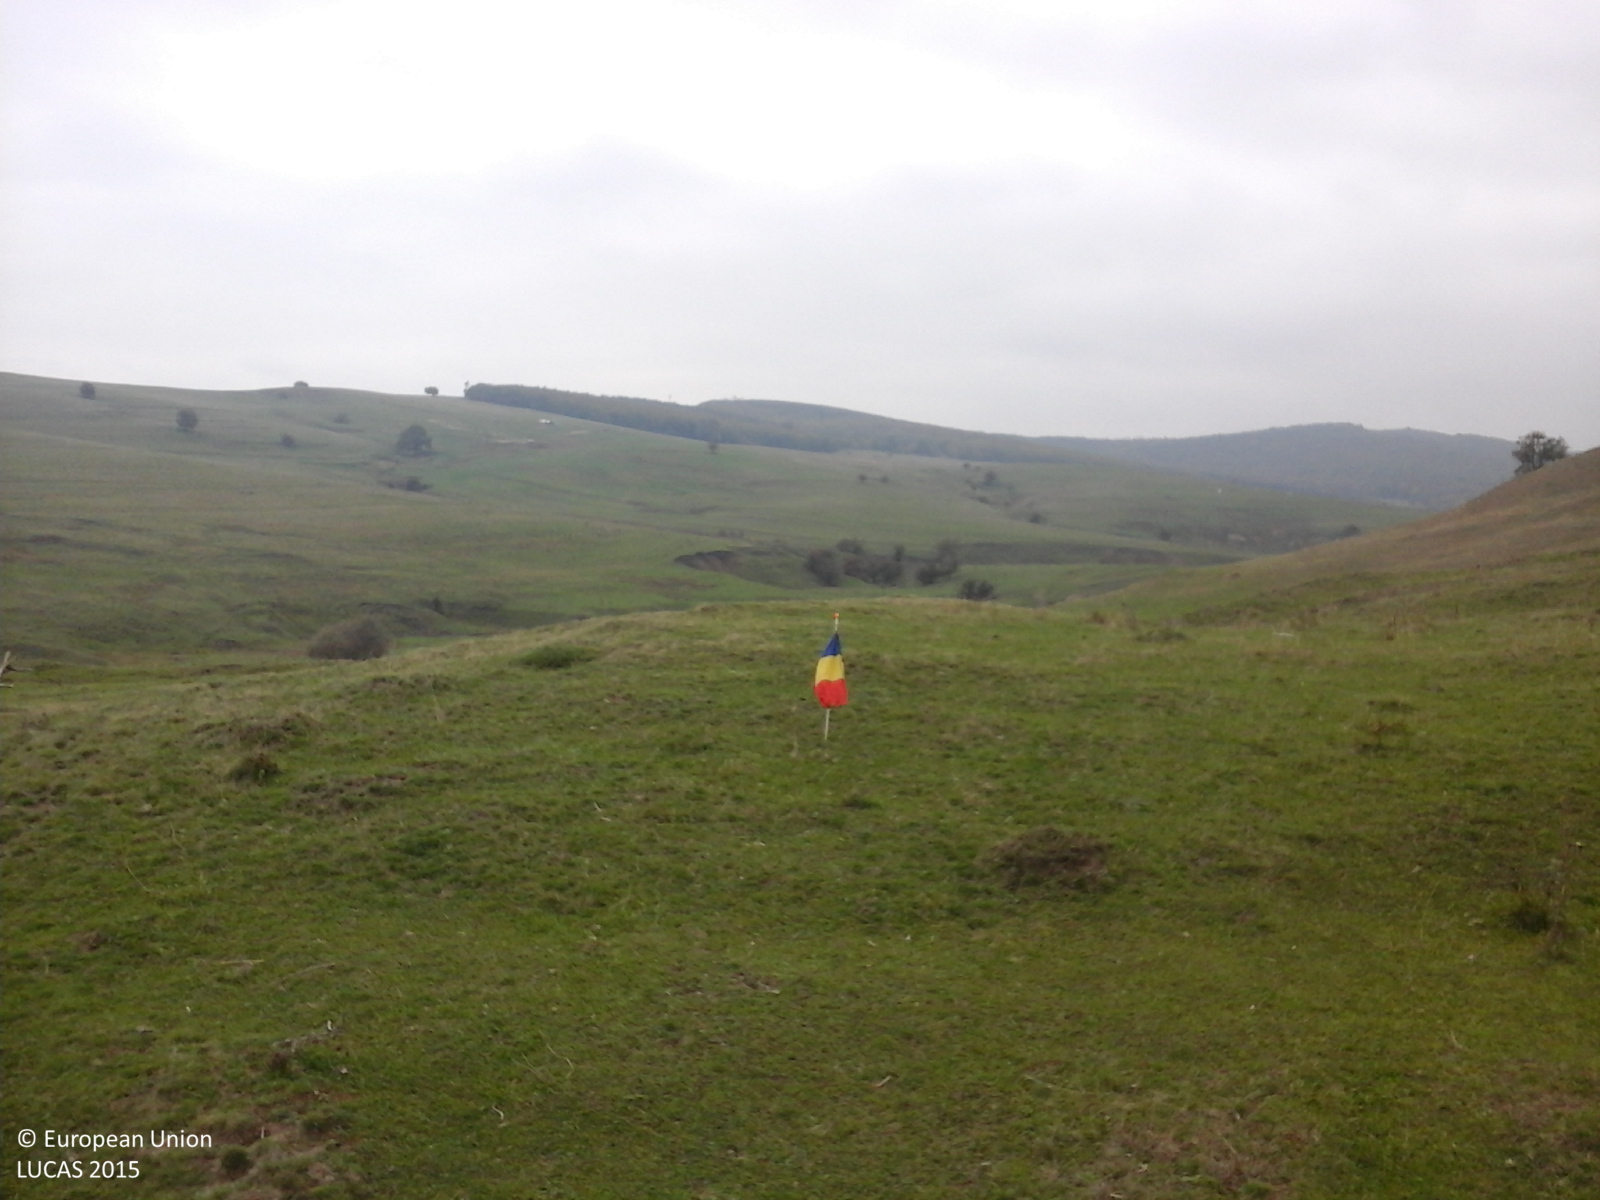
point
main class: Grassland
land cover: Grassland without tree/shrub cover
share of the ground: > 75 %
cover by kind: herbaceous plants 100 %
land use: Agriculture (excluding fallow land and kitchen gardens)
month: October
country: RO
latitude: 46.0196
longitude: 25.1189
